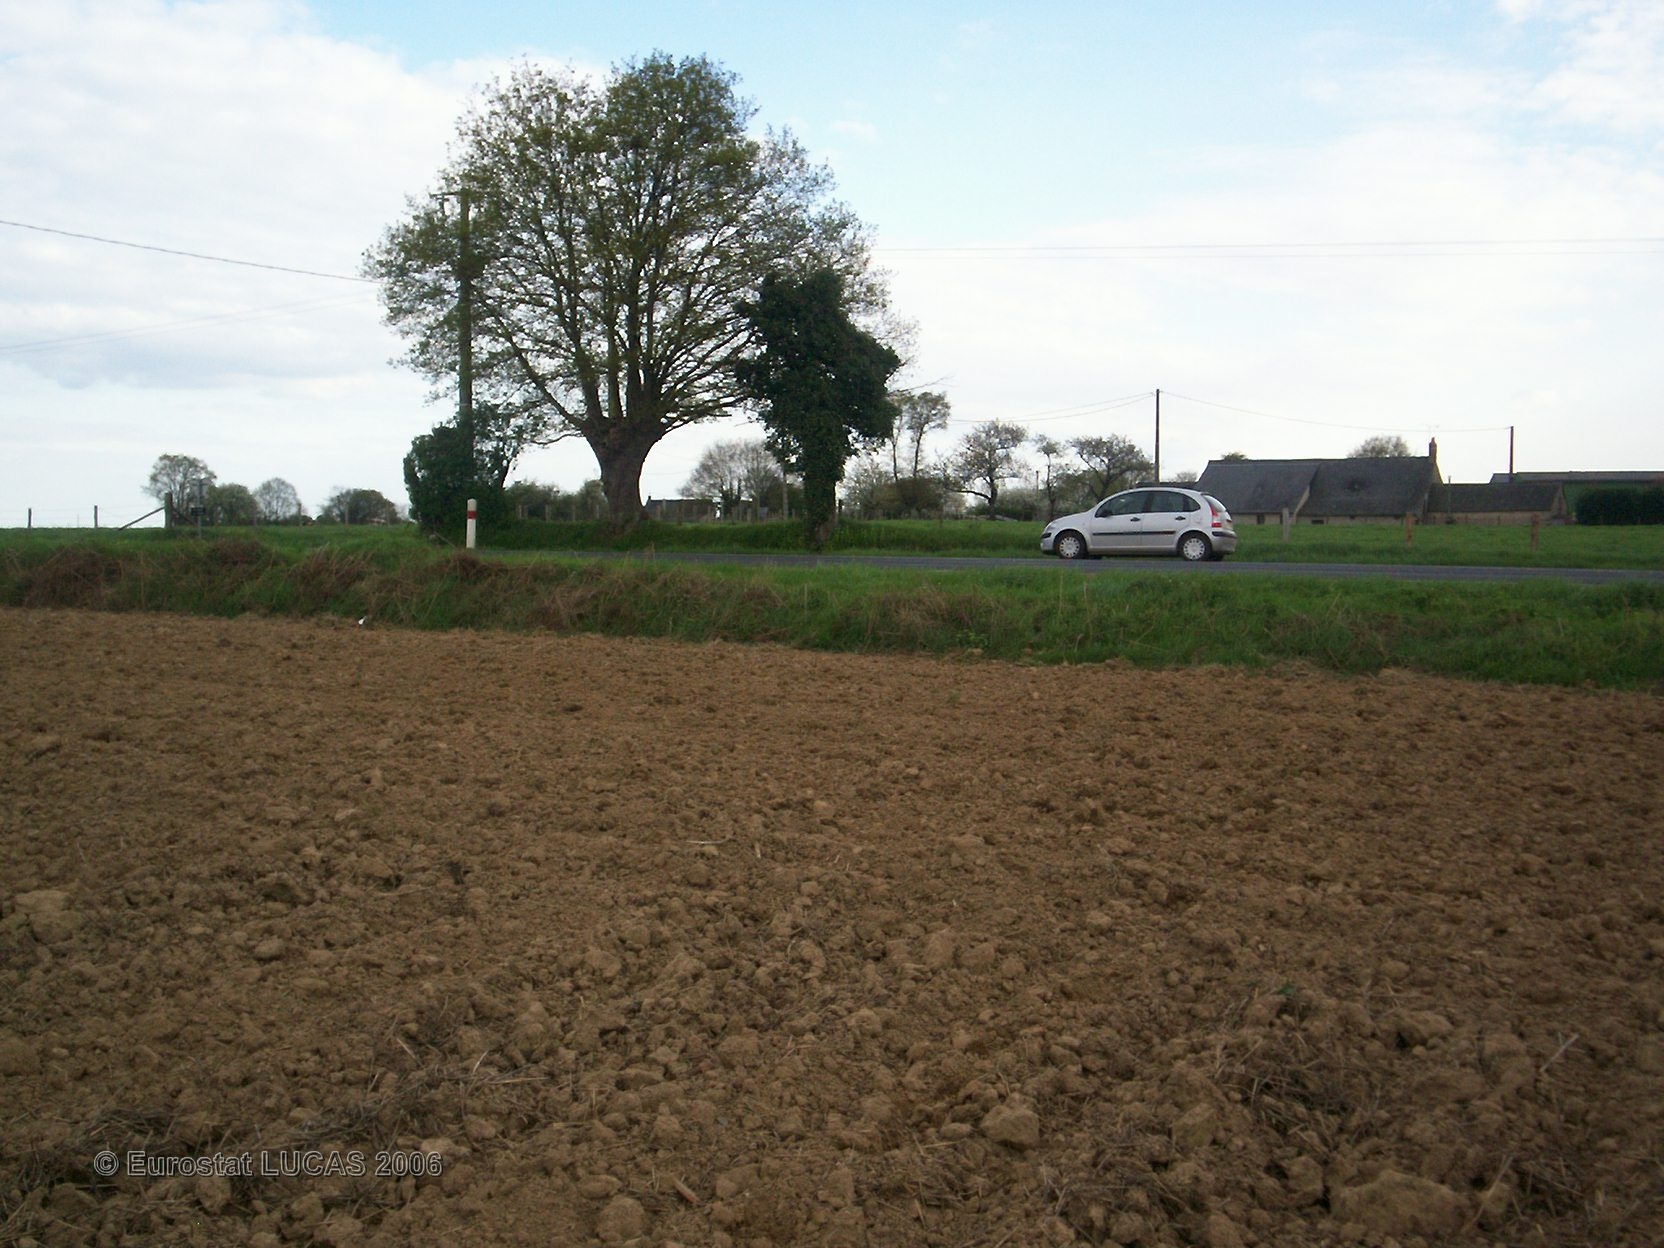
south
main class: Cropland
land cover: Maize
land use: Agriculture (excluding fallow land and kitchen gardens)
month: May
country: FR
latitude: 48.0206
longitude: -0.2067
